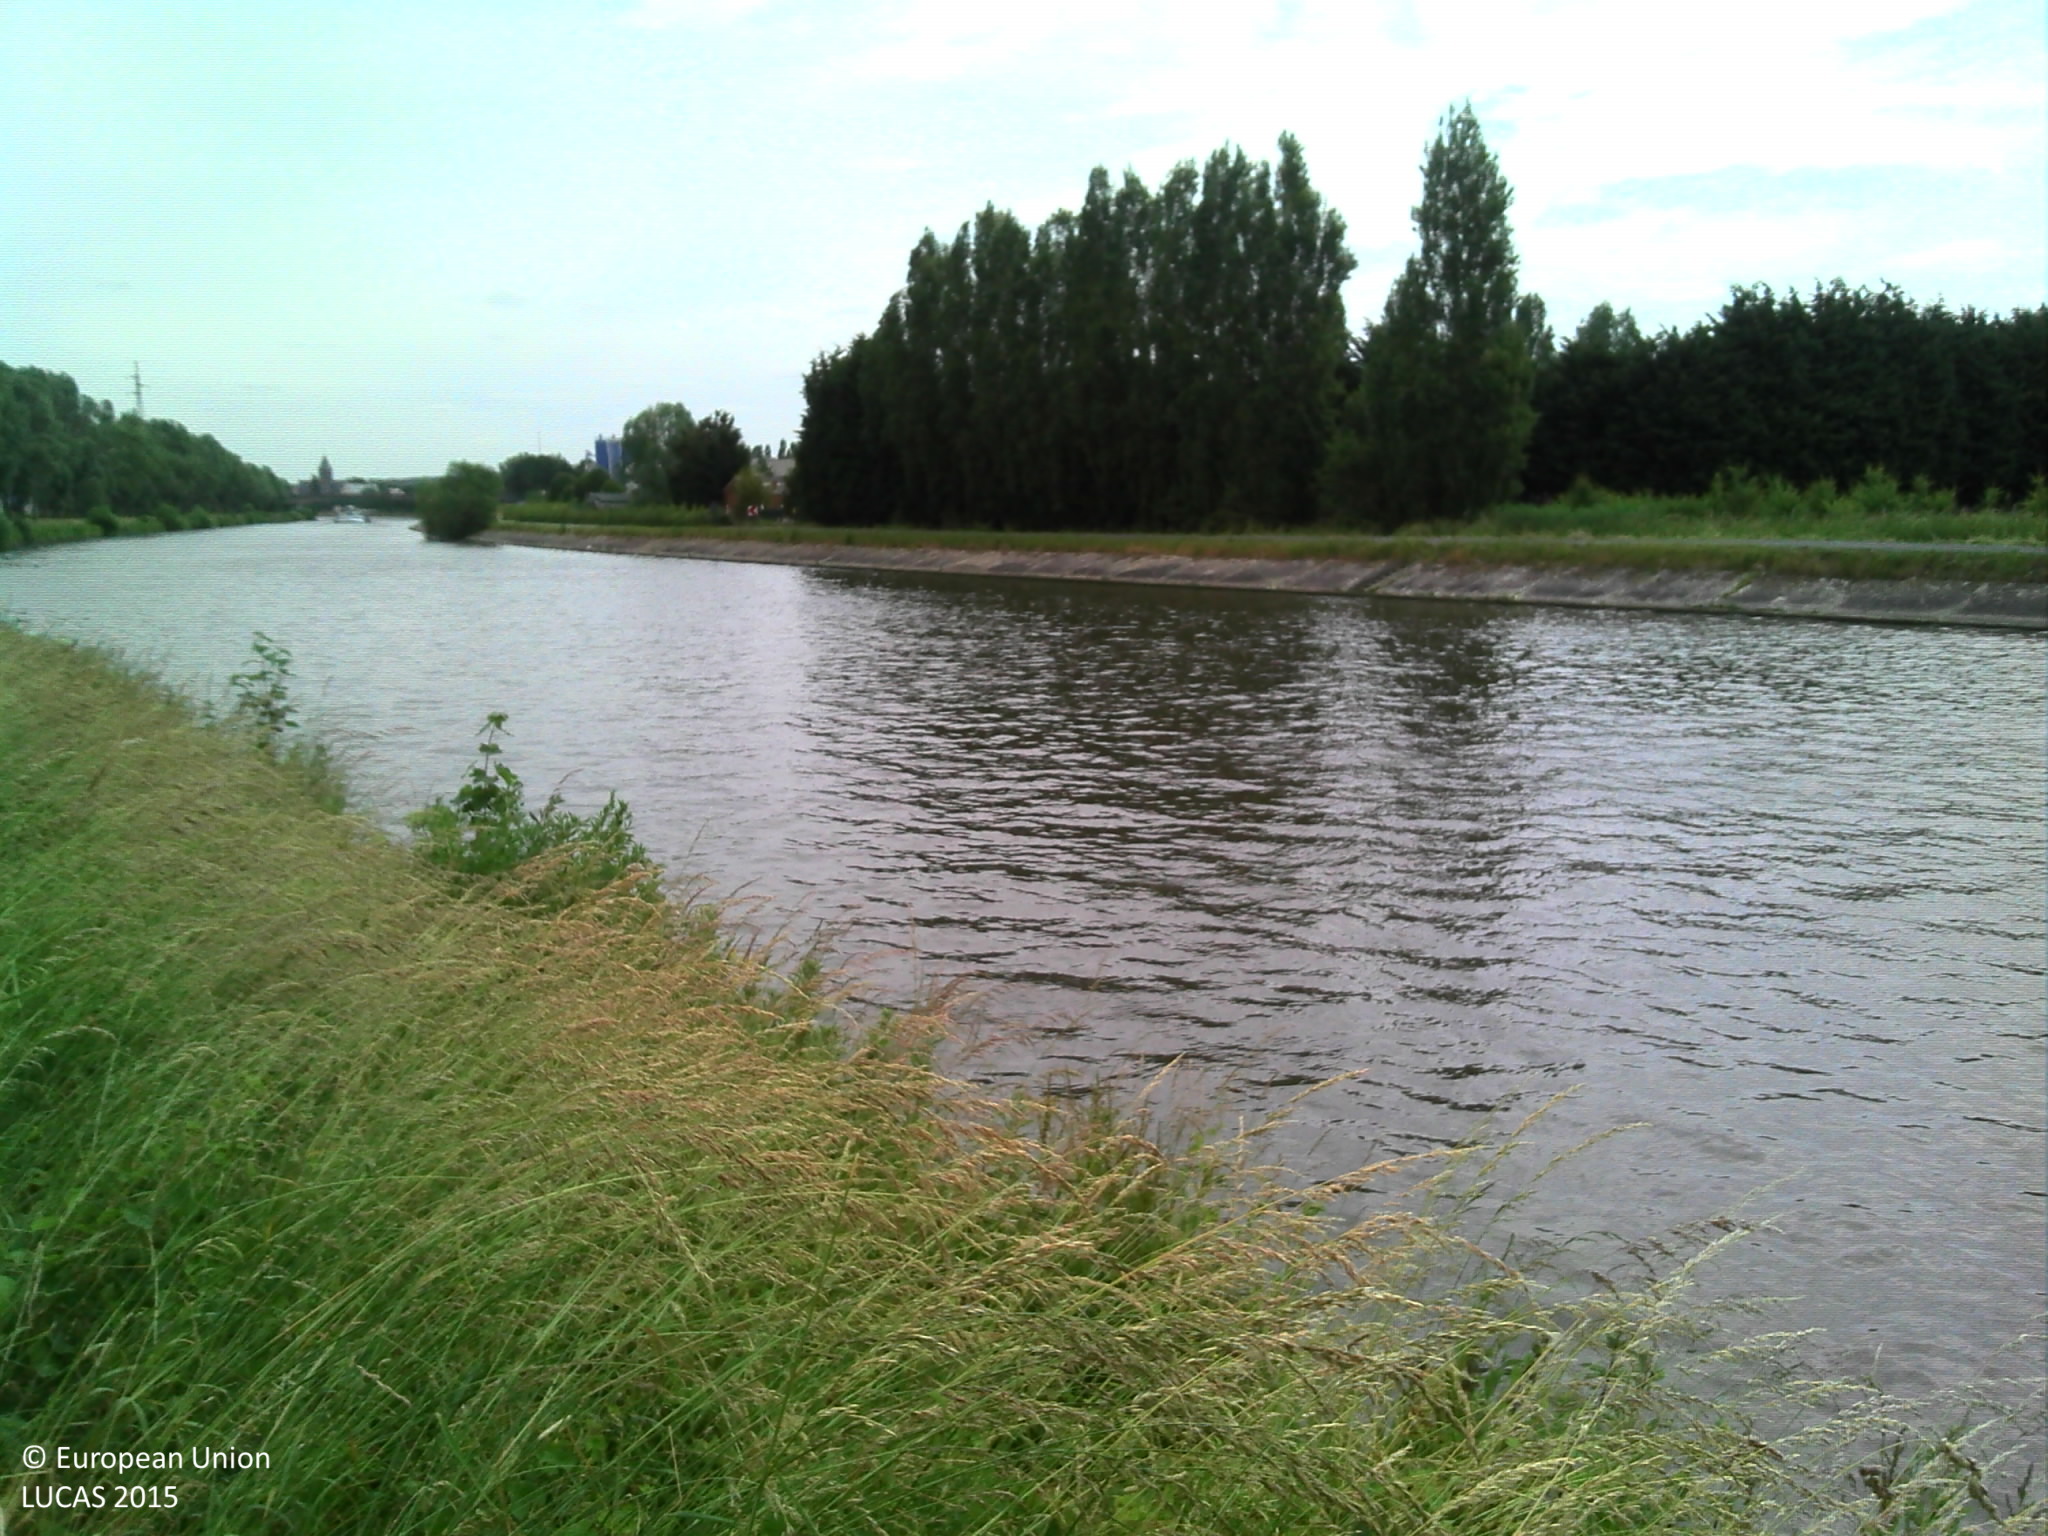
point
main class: Grassland
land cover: Spontaneously vegetated surfaces
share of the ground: > 75 %
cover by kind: herbaceous plants 100 %
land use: Semi-natural and natural areas not in use
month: June
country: BE
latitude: 50.8336
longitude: 3.5889
